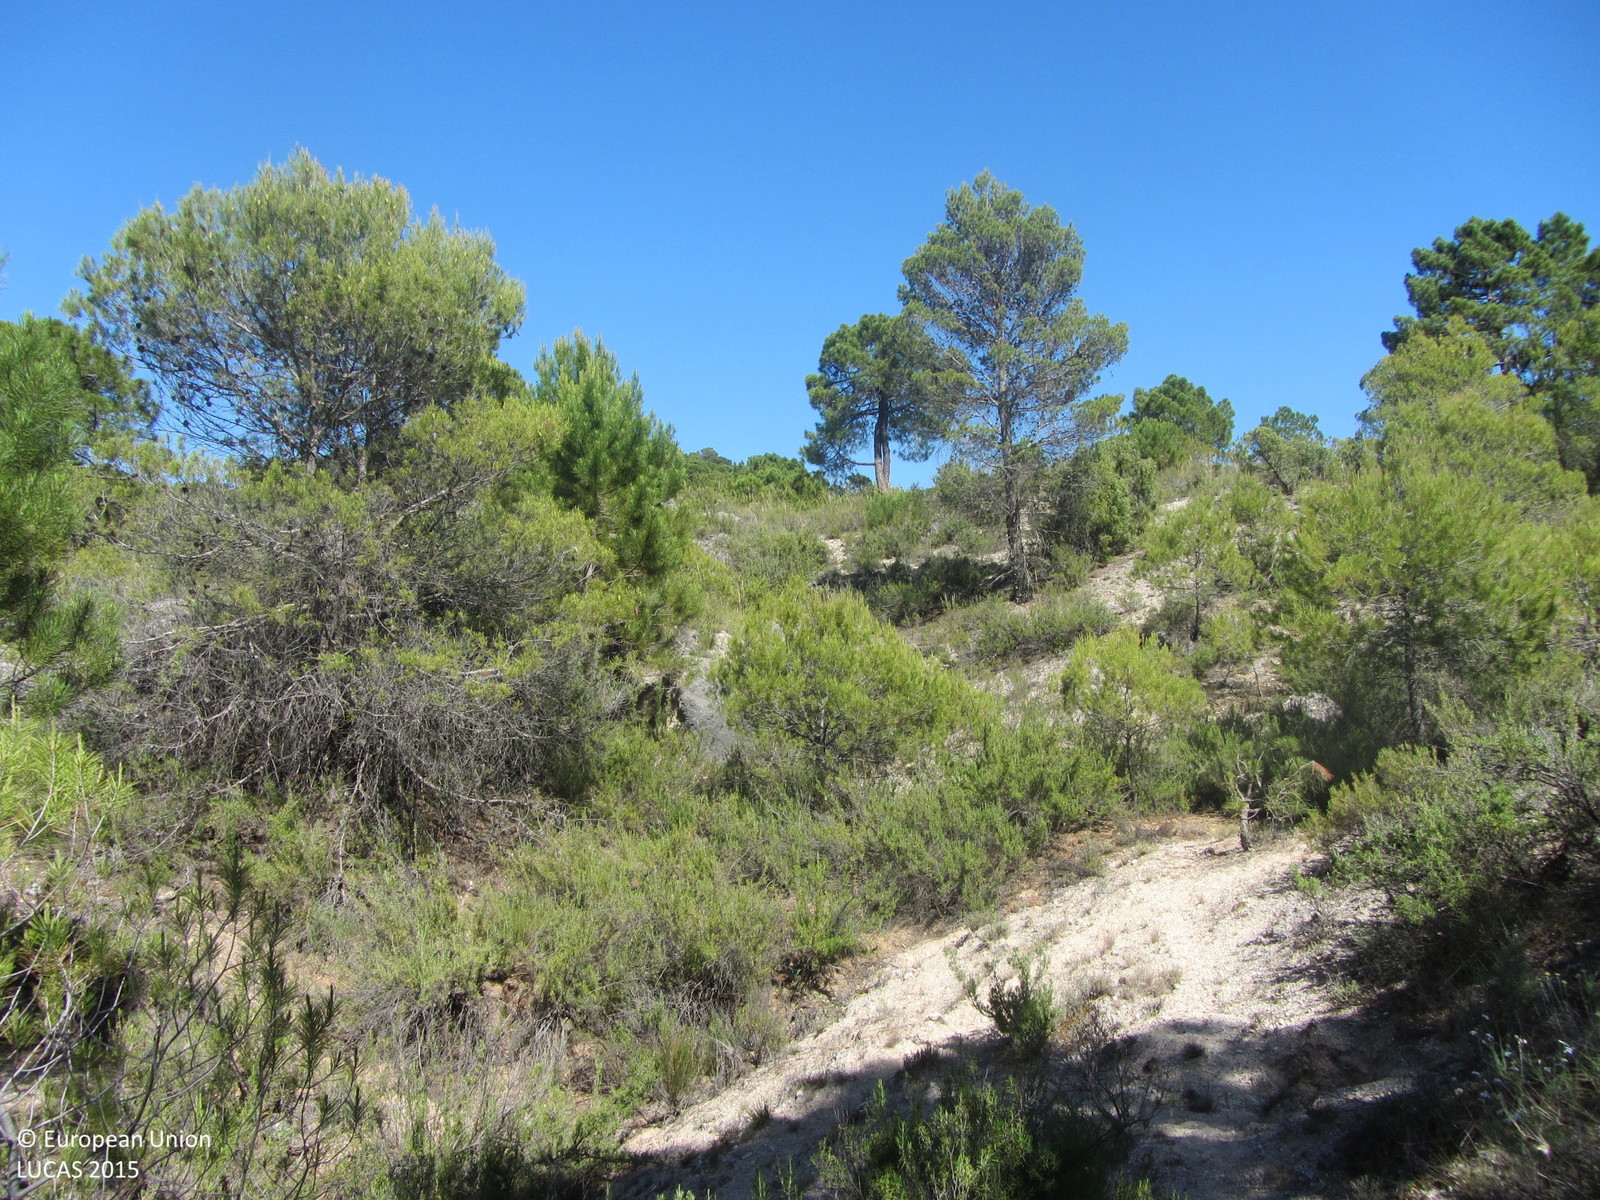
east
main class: Woodland
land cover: Pine dominated coniferous woodland
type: coniferous forest of the mediterranean region
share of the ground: 25 - 50 %
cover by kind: coniferous forest trees 35 %, shrubs 35 %, unconsolidated bare surface 20 %, herbaceous plants 10 %
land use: Forestry
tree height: > 5 m
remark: Clear cut
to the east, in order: Pine dominated coniferous woodland; Rivers and streams; Pine dominated coniferous woodland
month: June
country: ES
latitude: 38.4104
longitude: -2.5845
